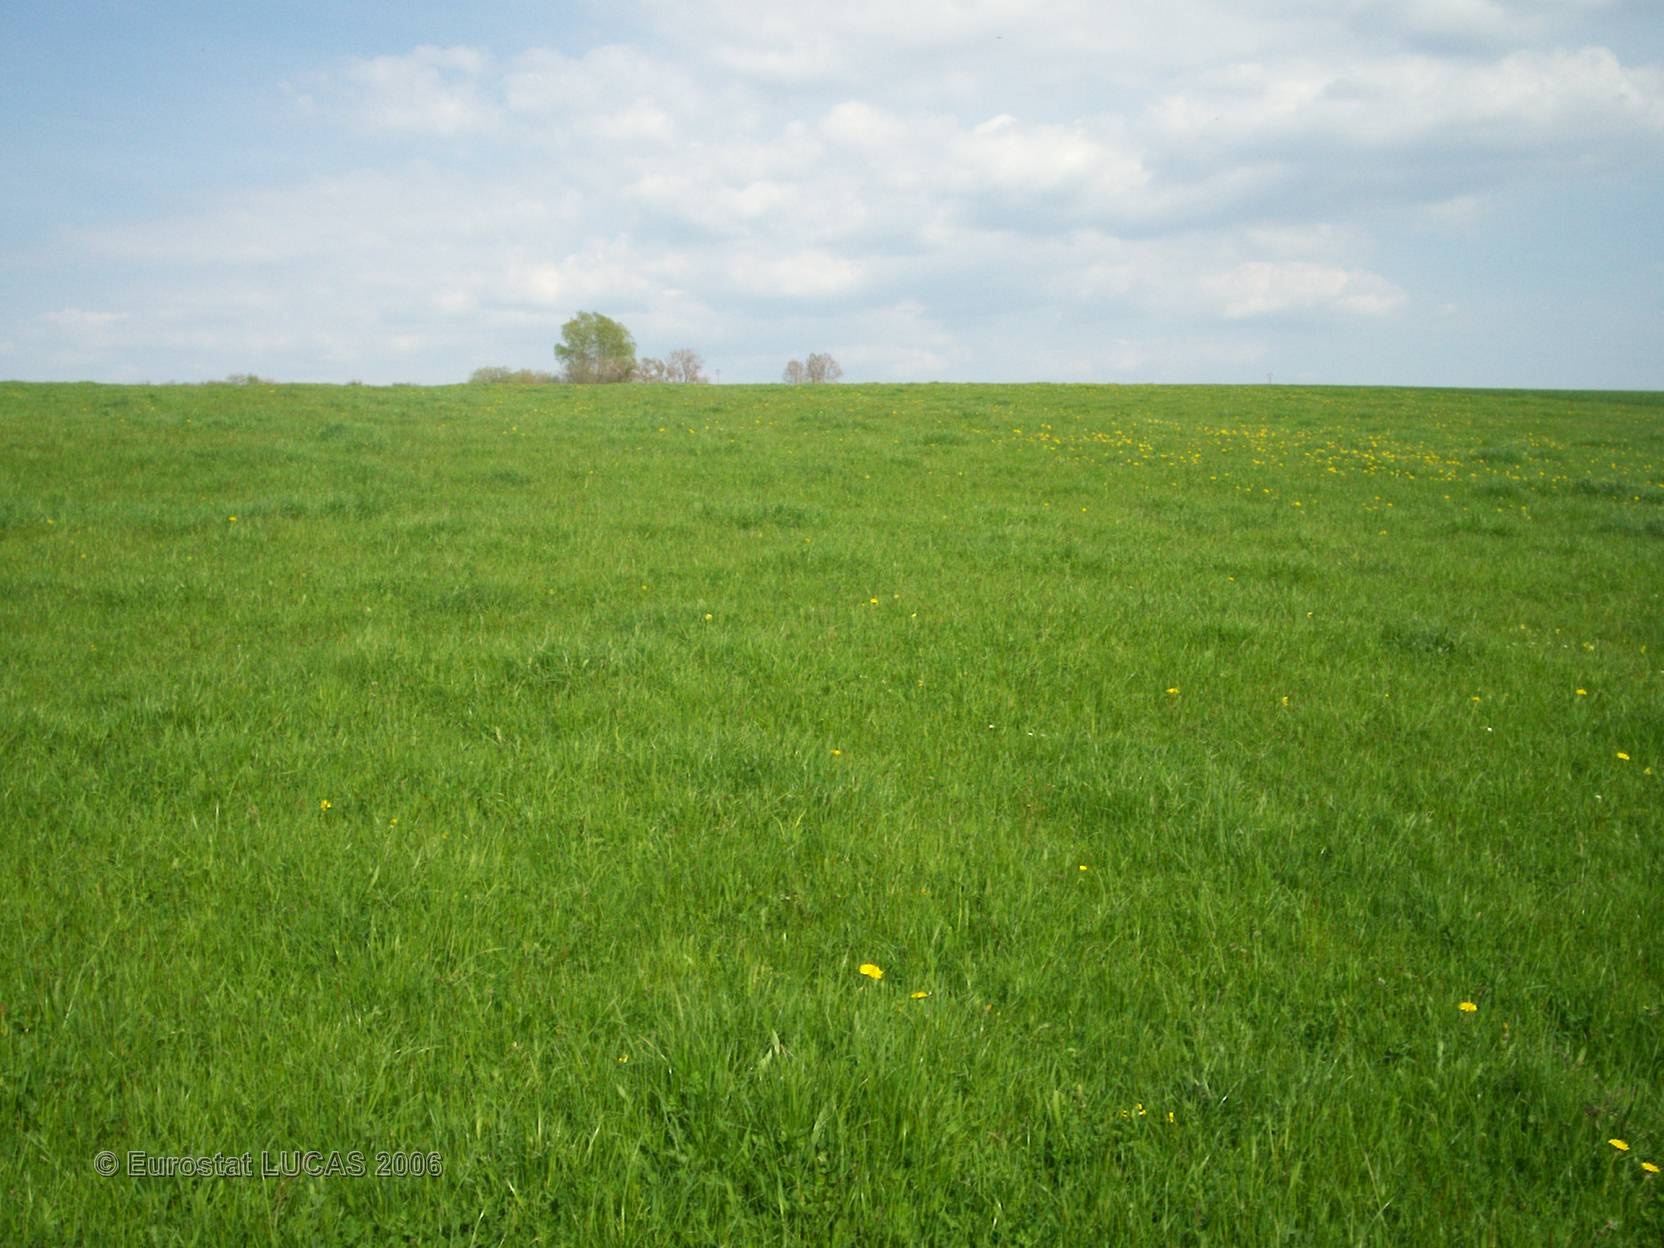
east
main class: Grassland
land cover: Grassland without tree/shrub cover
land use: Agriculture (excluding fallow land and kitchen gardens)
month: May
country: FR
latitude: 49.1099
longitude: 7.3566
